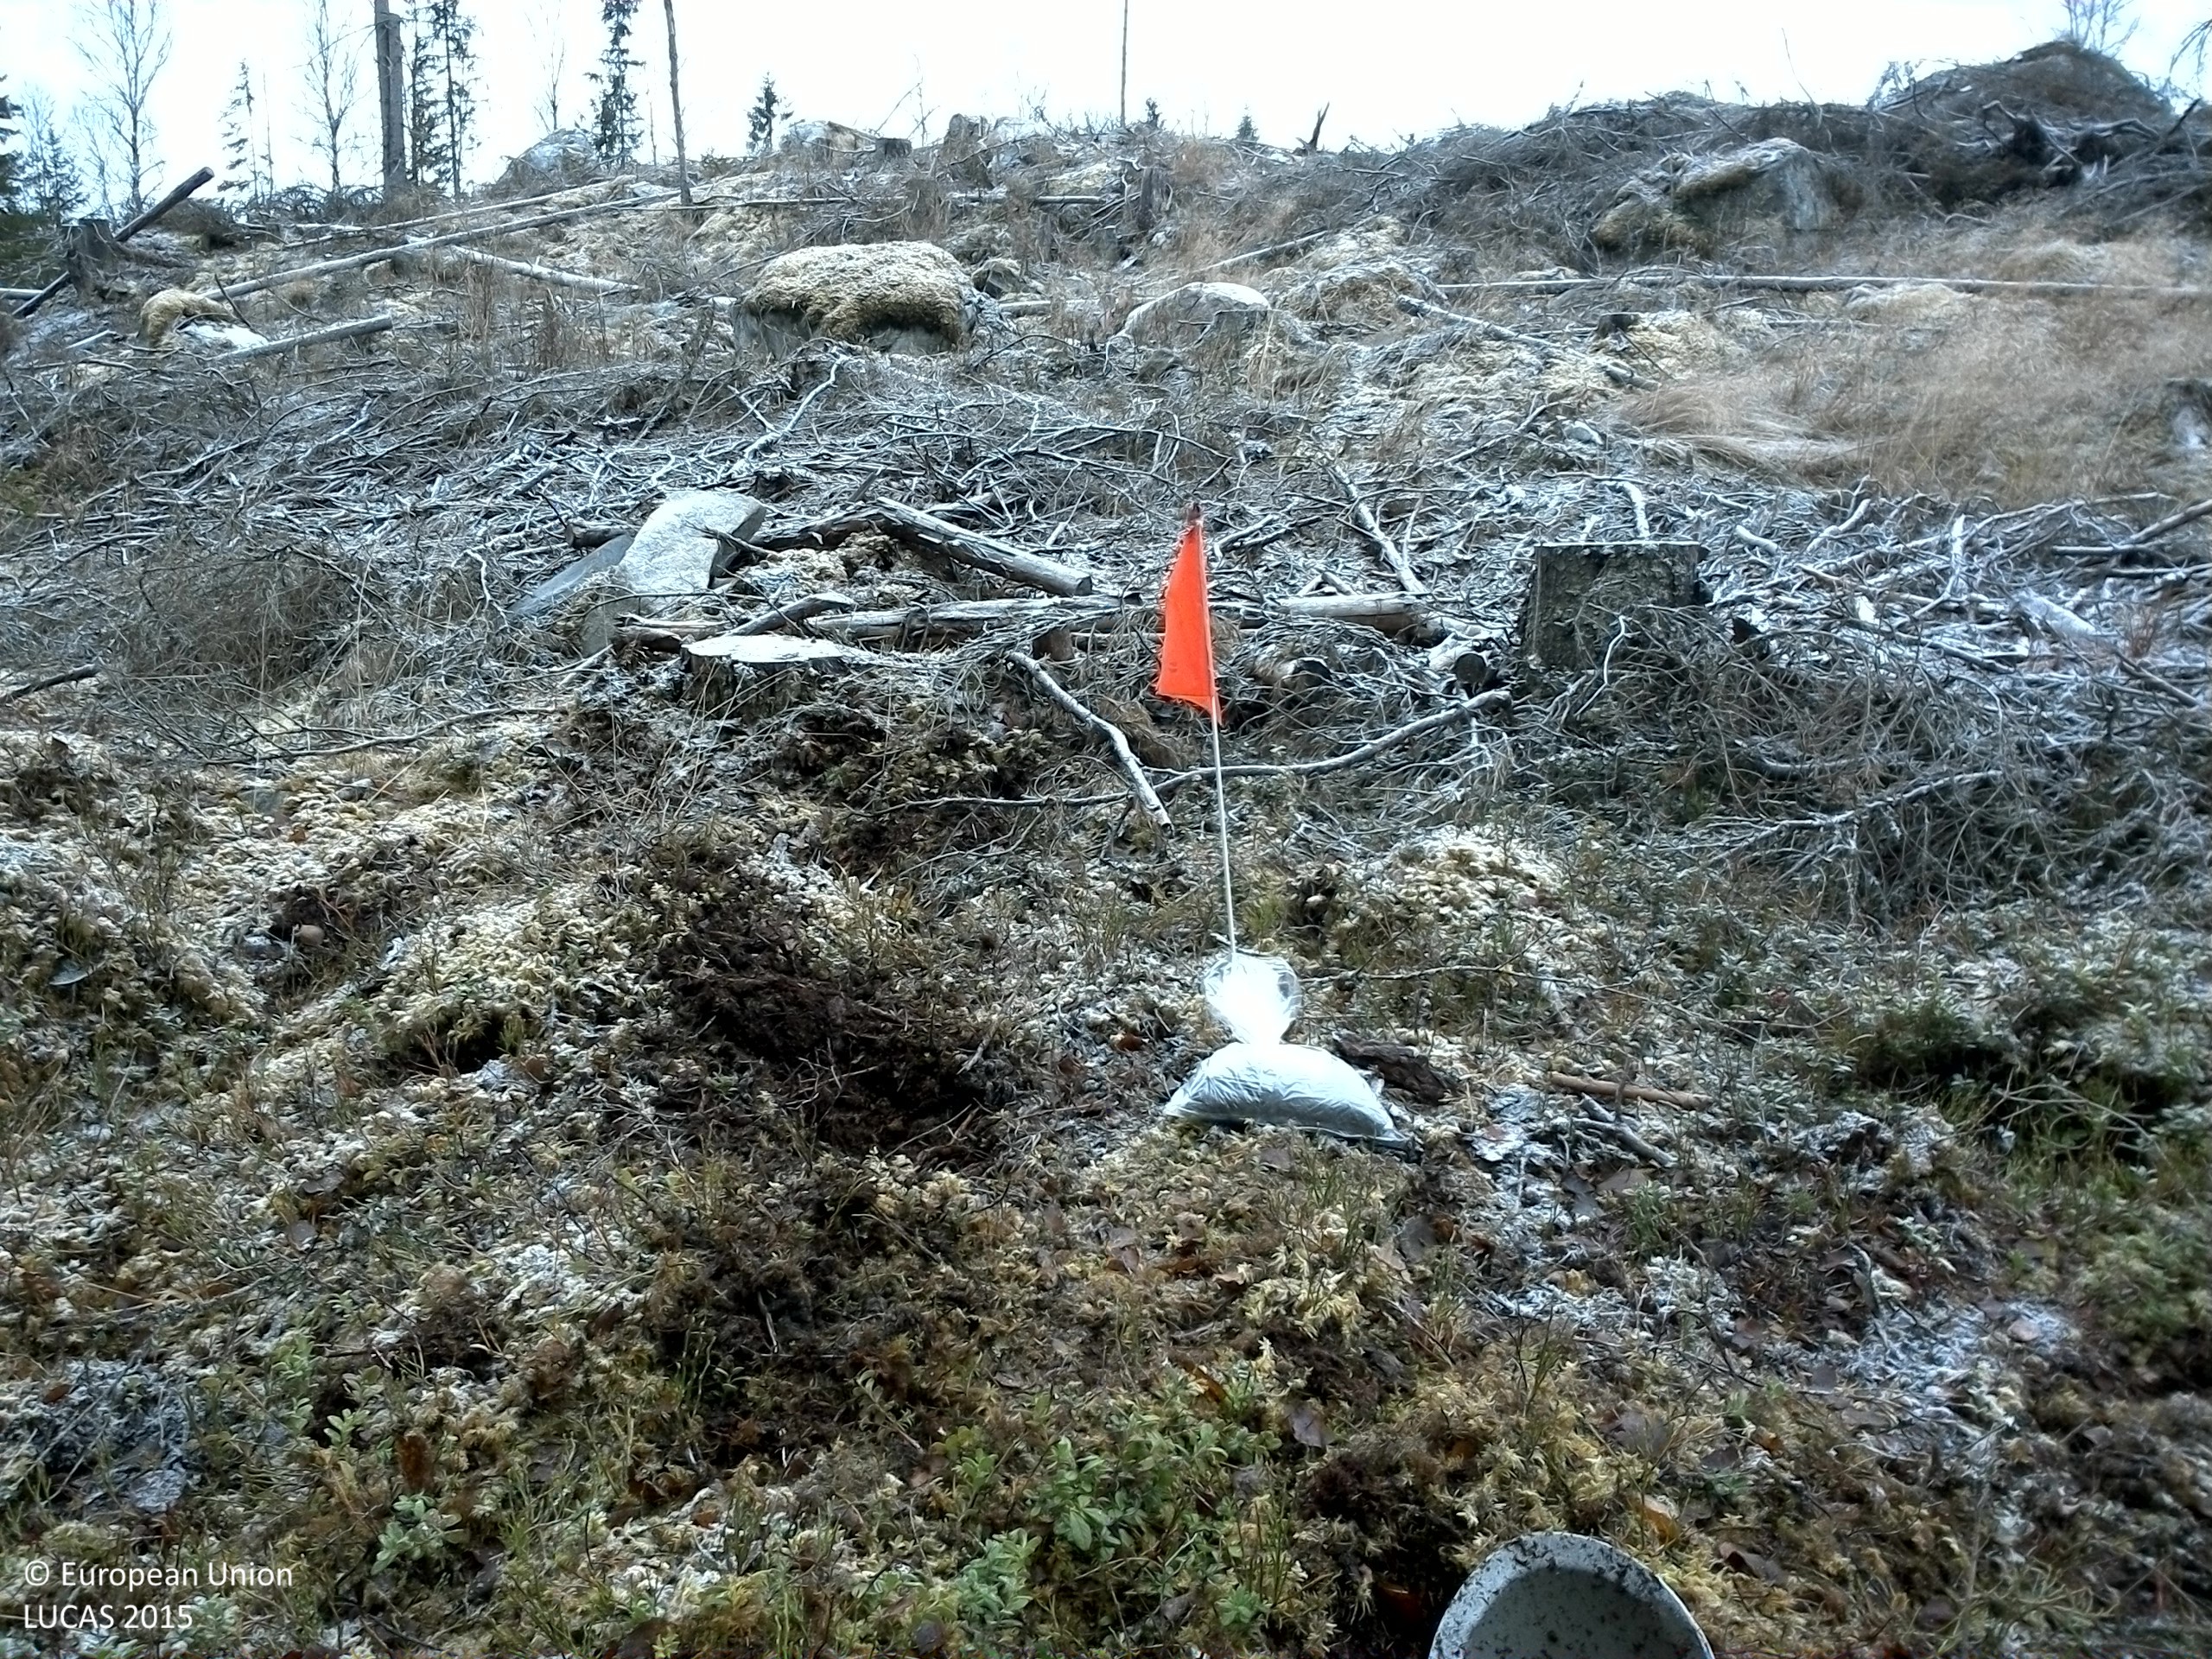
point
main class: Shrubland
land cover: Shrubland without tree cover
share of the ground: 25 - 50 %
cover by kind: shrubs 40 %, consolidated bare surface 30 %, herbaceous plants 15 %, lichens and mosses 15 %
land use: Forestry
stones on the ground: 10 - 25 %
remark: Clear cut
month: November
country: SE
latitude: 60.1393
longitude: 15.6609
